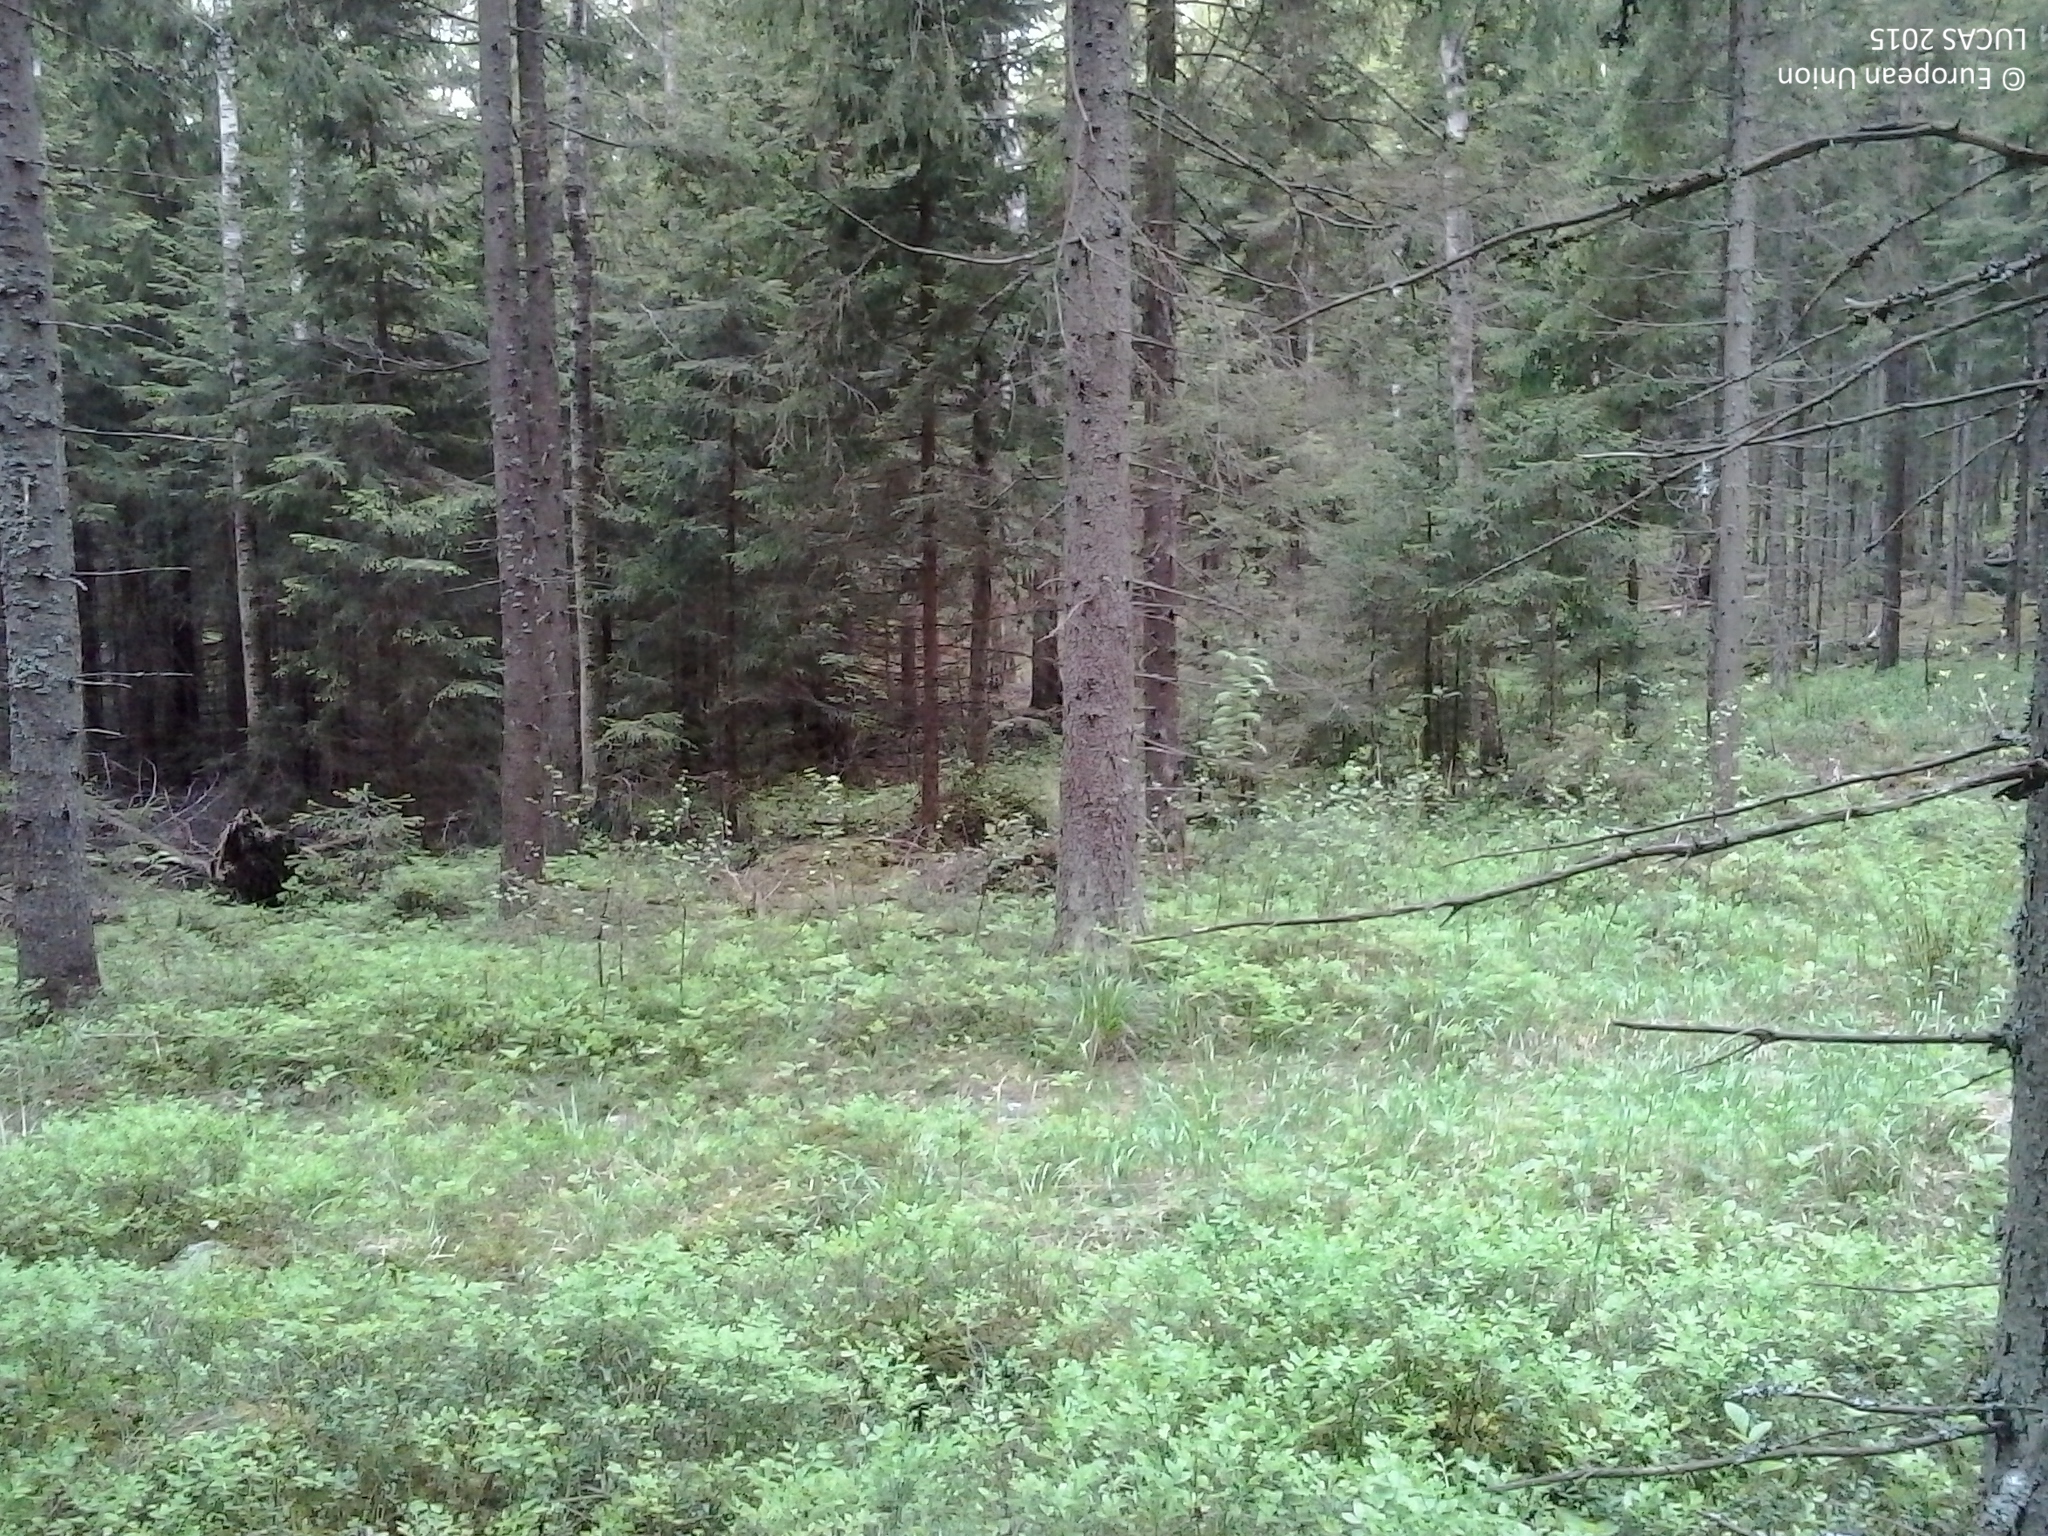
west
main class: Woodland
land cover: Spruce dominated coniferous woodland
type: boreal forest
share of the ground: 50 - 75 %
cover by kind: coniferous forest trees 55 %, broadleaved forest trees 15 %, shrubs 10 %, herbaceous plants 10 %, lichens and mosses 10 %
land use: Forestry
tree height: > 5 m
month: June
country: SE
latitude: 59.3644
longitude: 14.0909
